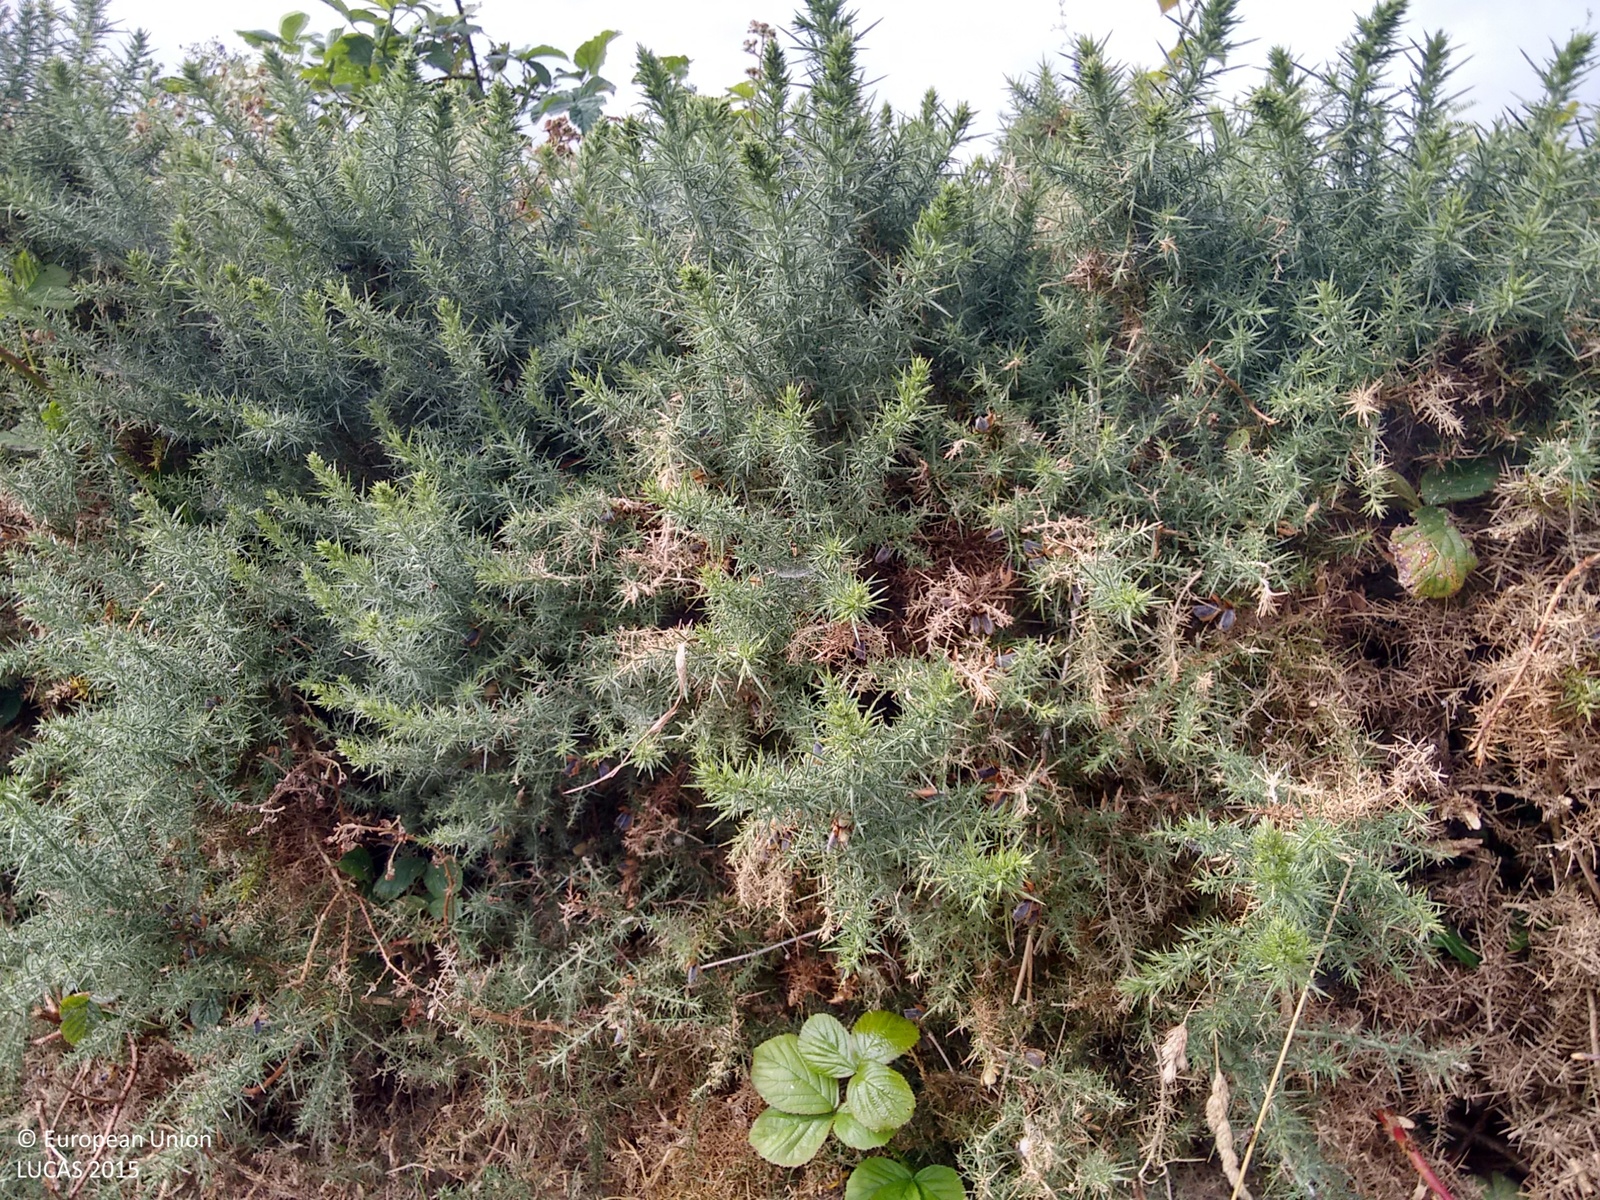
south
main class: Cropland
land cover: Oats
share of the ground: > 75 %
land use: Agriculture (excluding fallow land and kitchen gardens)
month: July
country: IE
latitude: 52.1247
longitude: -8.9513
